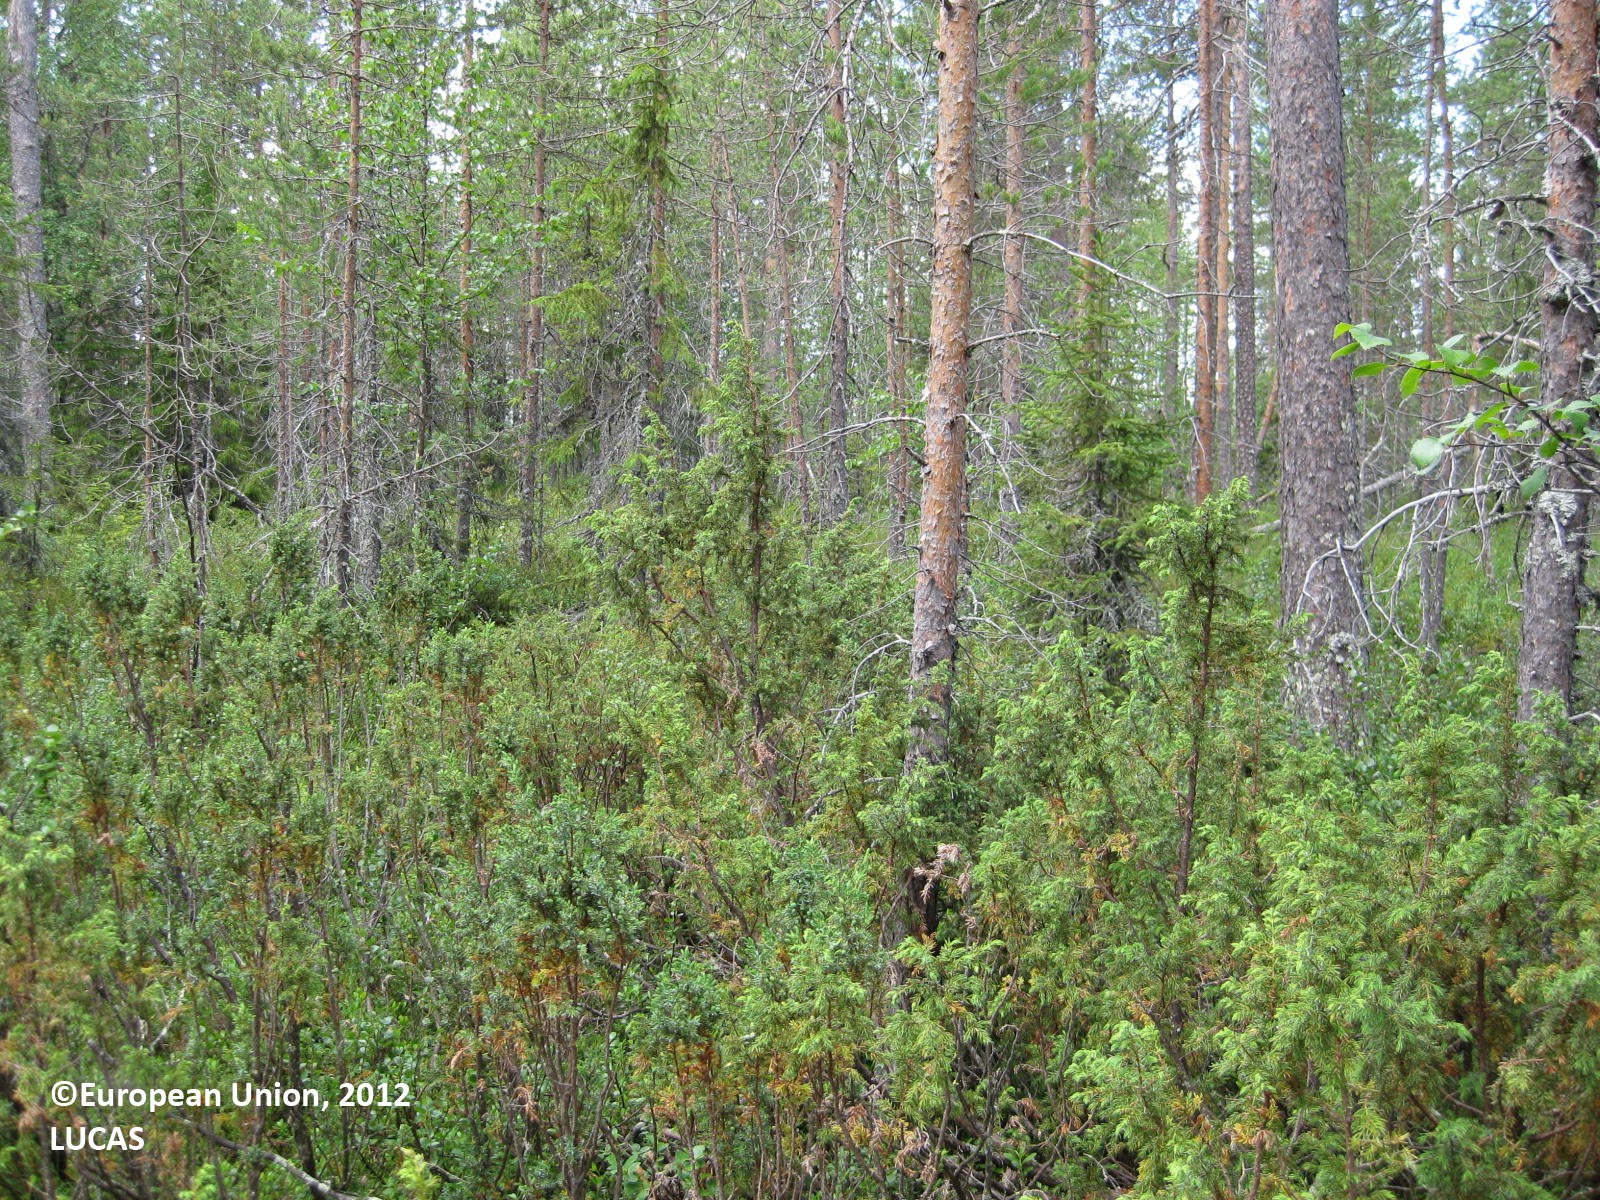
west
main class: Woodland
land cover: Pine dominated mixed woodland
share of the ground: > 75 %
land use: Forestry
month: July
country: FI
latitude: 65.6678
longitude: 29.3073
